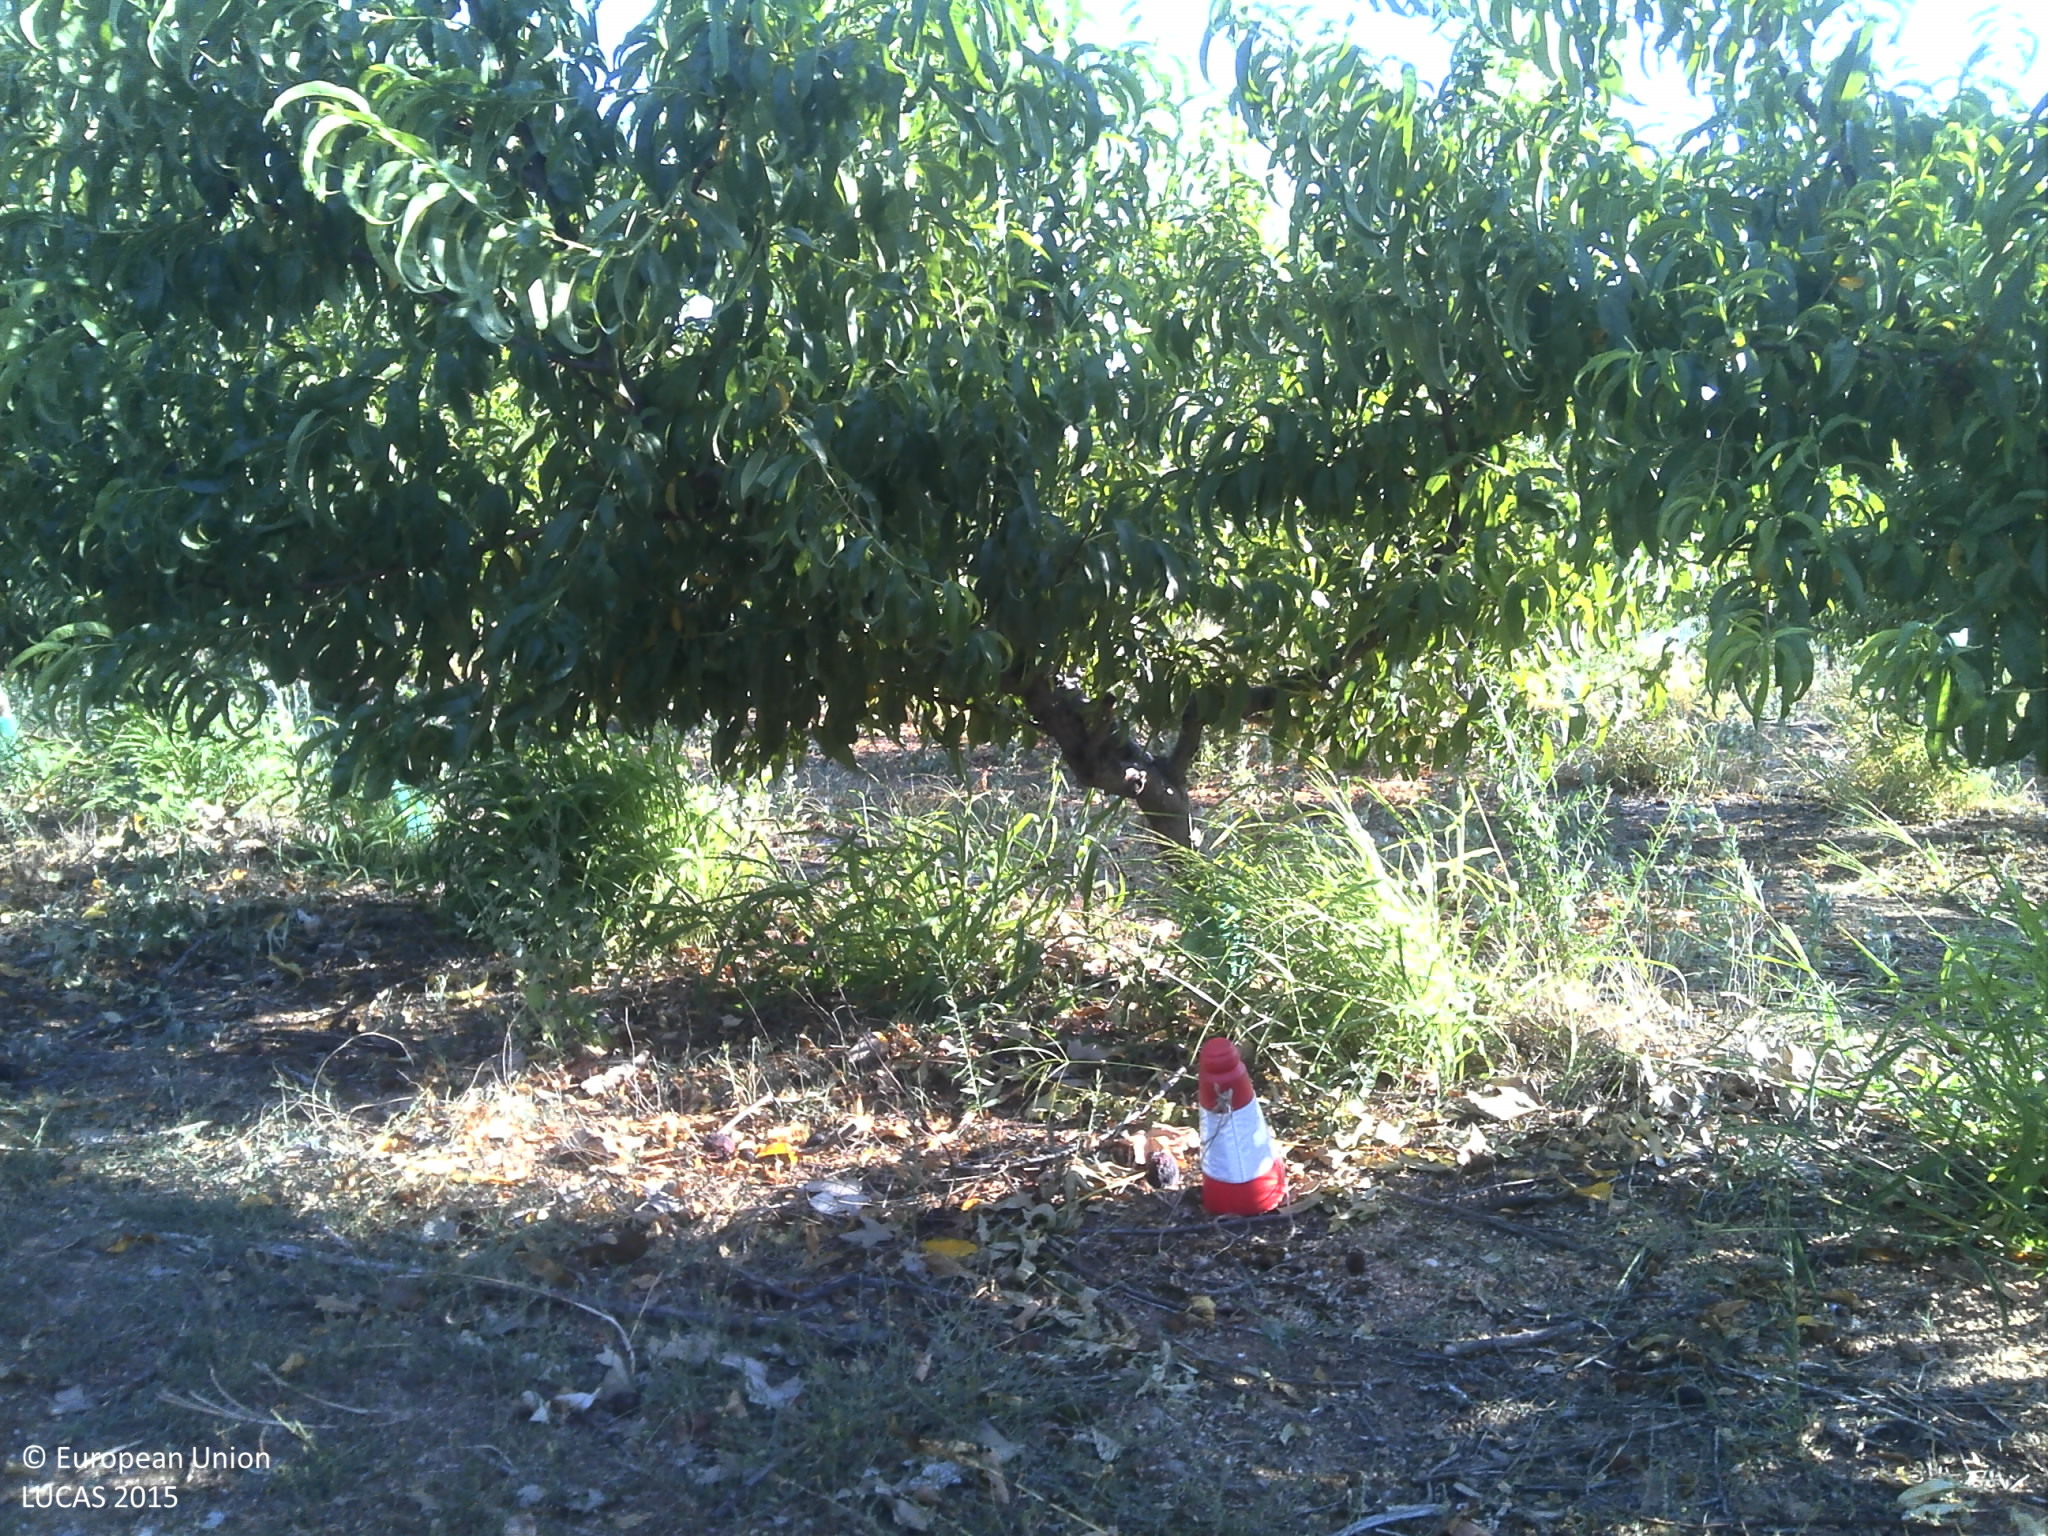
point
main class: Cropland
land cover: Other fruit trees and berries
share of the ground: 50 - 75 %
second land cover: Spontaneously vegetated surfaces
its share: 10 - 25 %
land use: Agriculture (excluding fallow land and kitchen gardens)
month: July
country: PT
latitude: 40.3415
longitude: -7.3990
